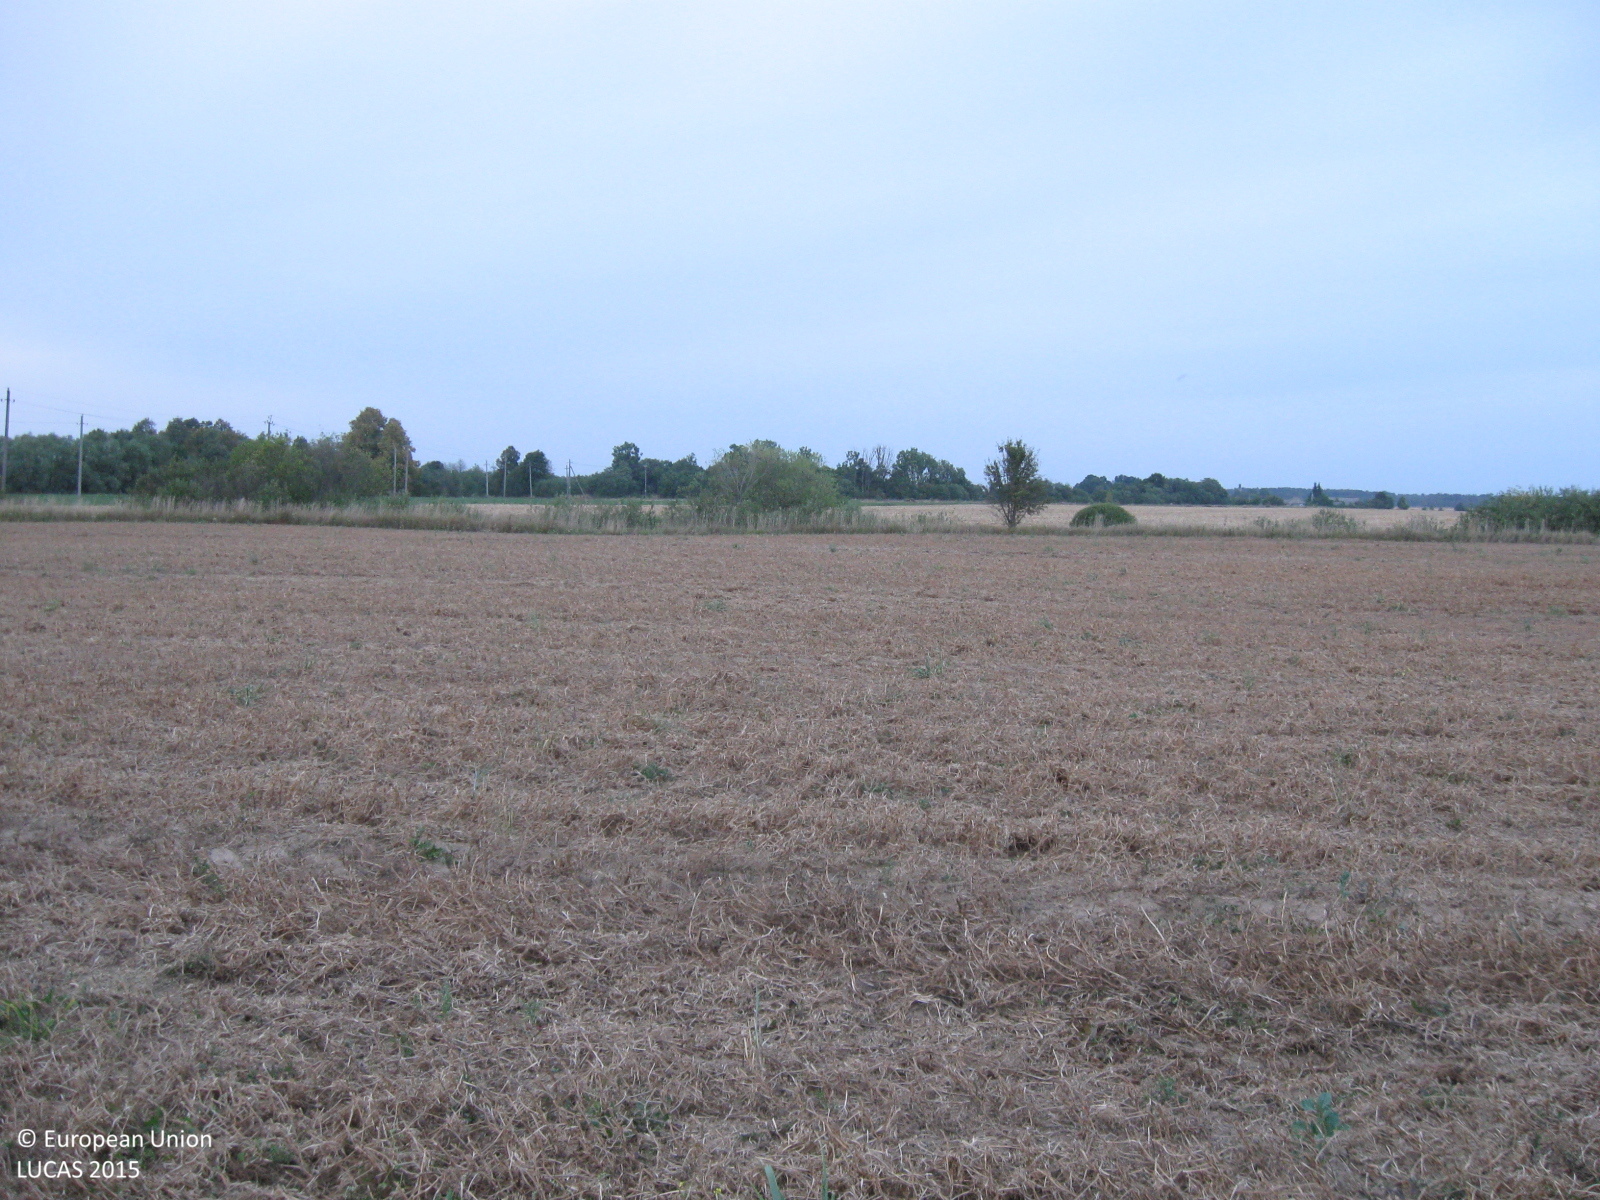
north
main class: Cropland
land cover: Dry pulses
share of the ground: 10 - 25 %
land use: Agriculture (excluding fallow land and kitchen gardens)
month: August
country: LT
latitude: 55.1816
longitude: 23.1230
